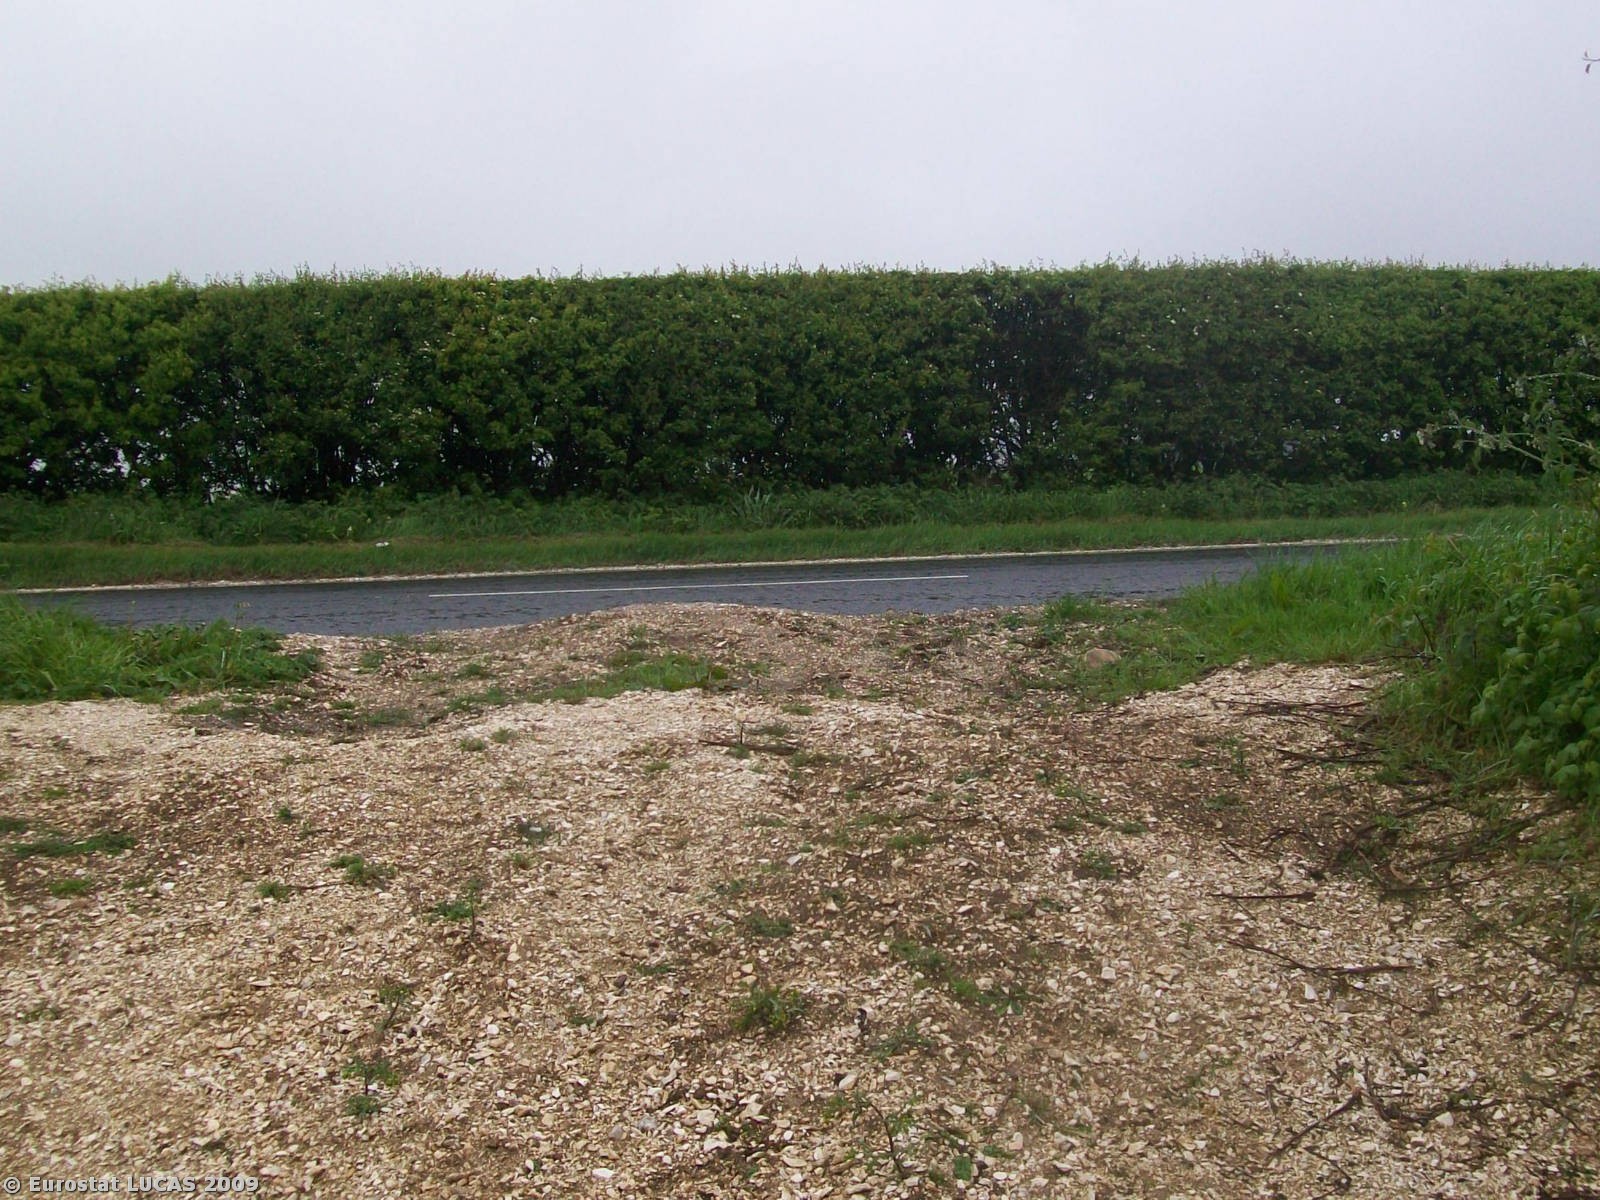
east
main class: Cropland
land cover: Common wheat
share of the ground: > 75 %
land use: Agriculture (excluding fallow land and kitchen gardens)
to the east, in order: Common wheat; Grass margins; Managed hedges; Grass margins; Paved roads, cycling and walking lanes; Grass margins; Managed hedges; Grass margins; Barley
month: May
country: GB
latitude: 54.1268
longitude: -0.4566
